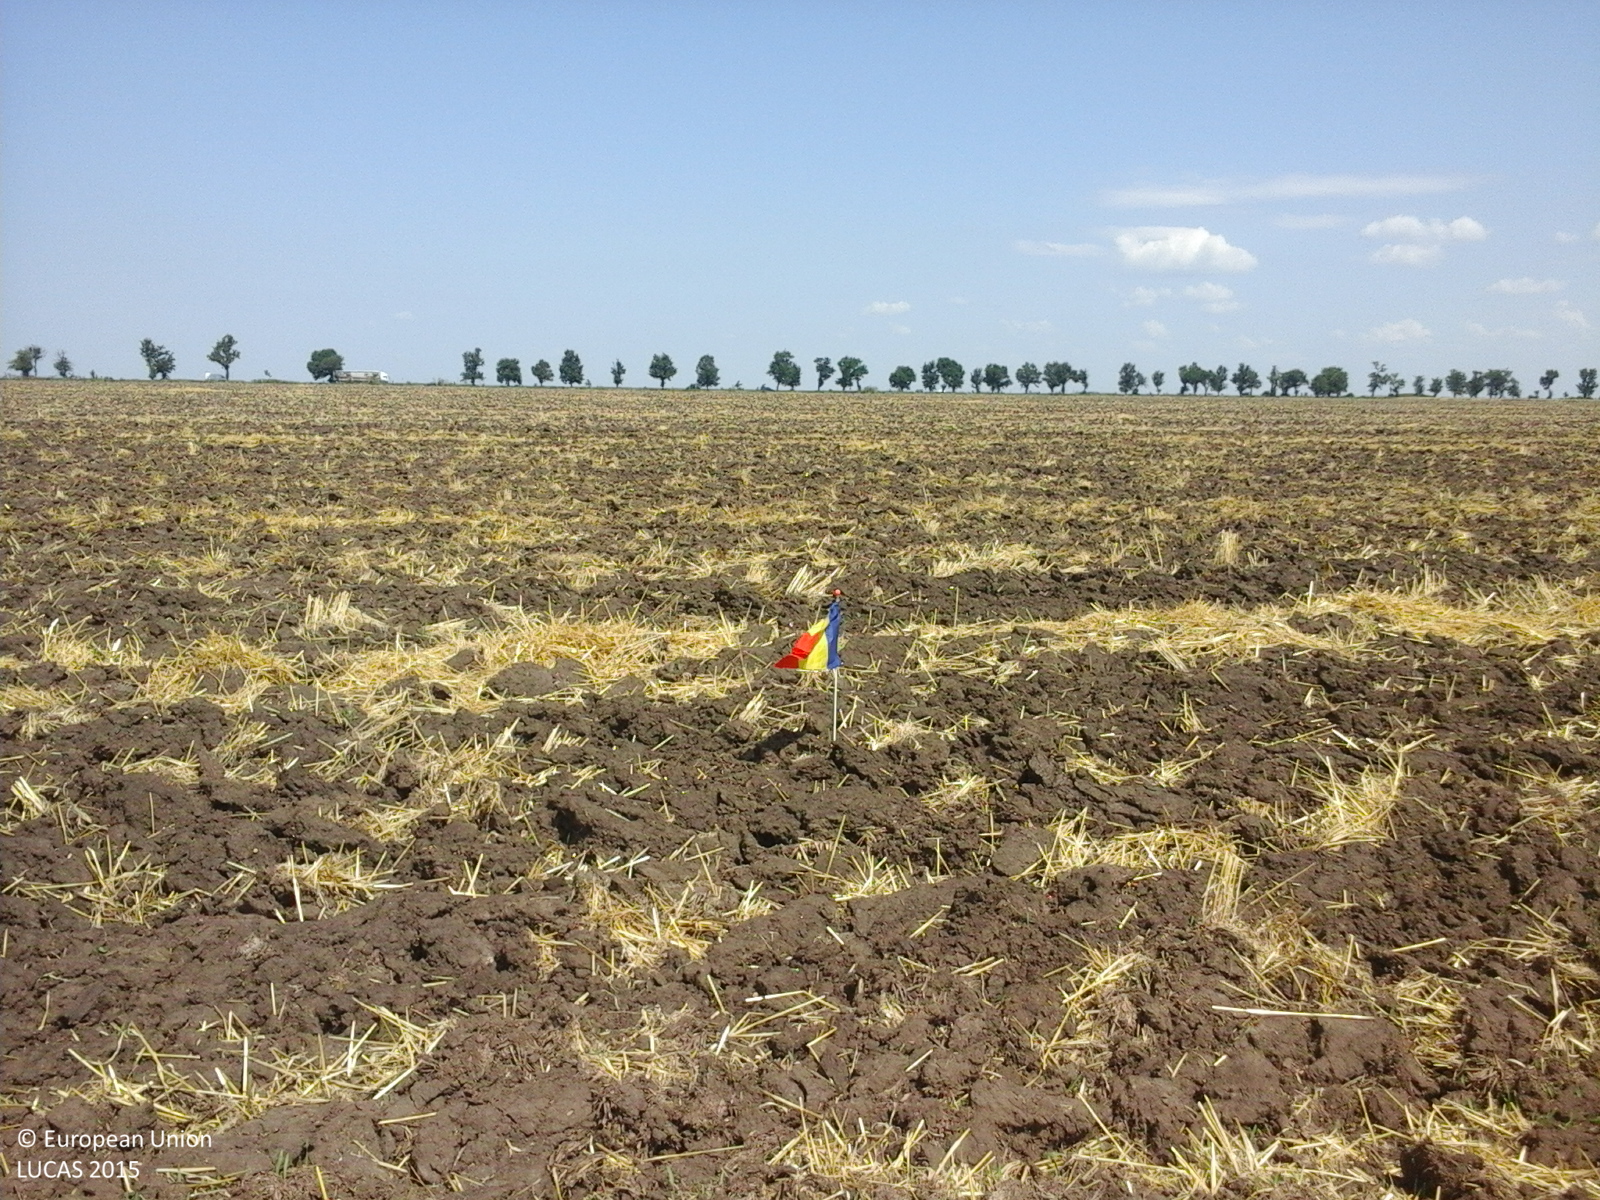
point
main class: Cropland
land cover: Common wheat
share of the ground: < 10 %
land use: Agriculture (excluding fallow land and kitchen gardens)
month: July
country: RO
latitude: 43.9179
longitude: 25.2111
